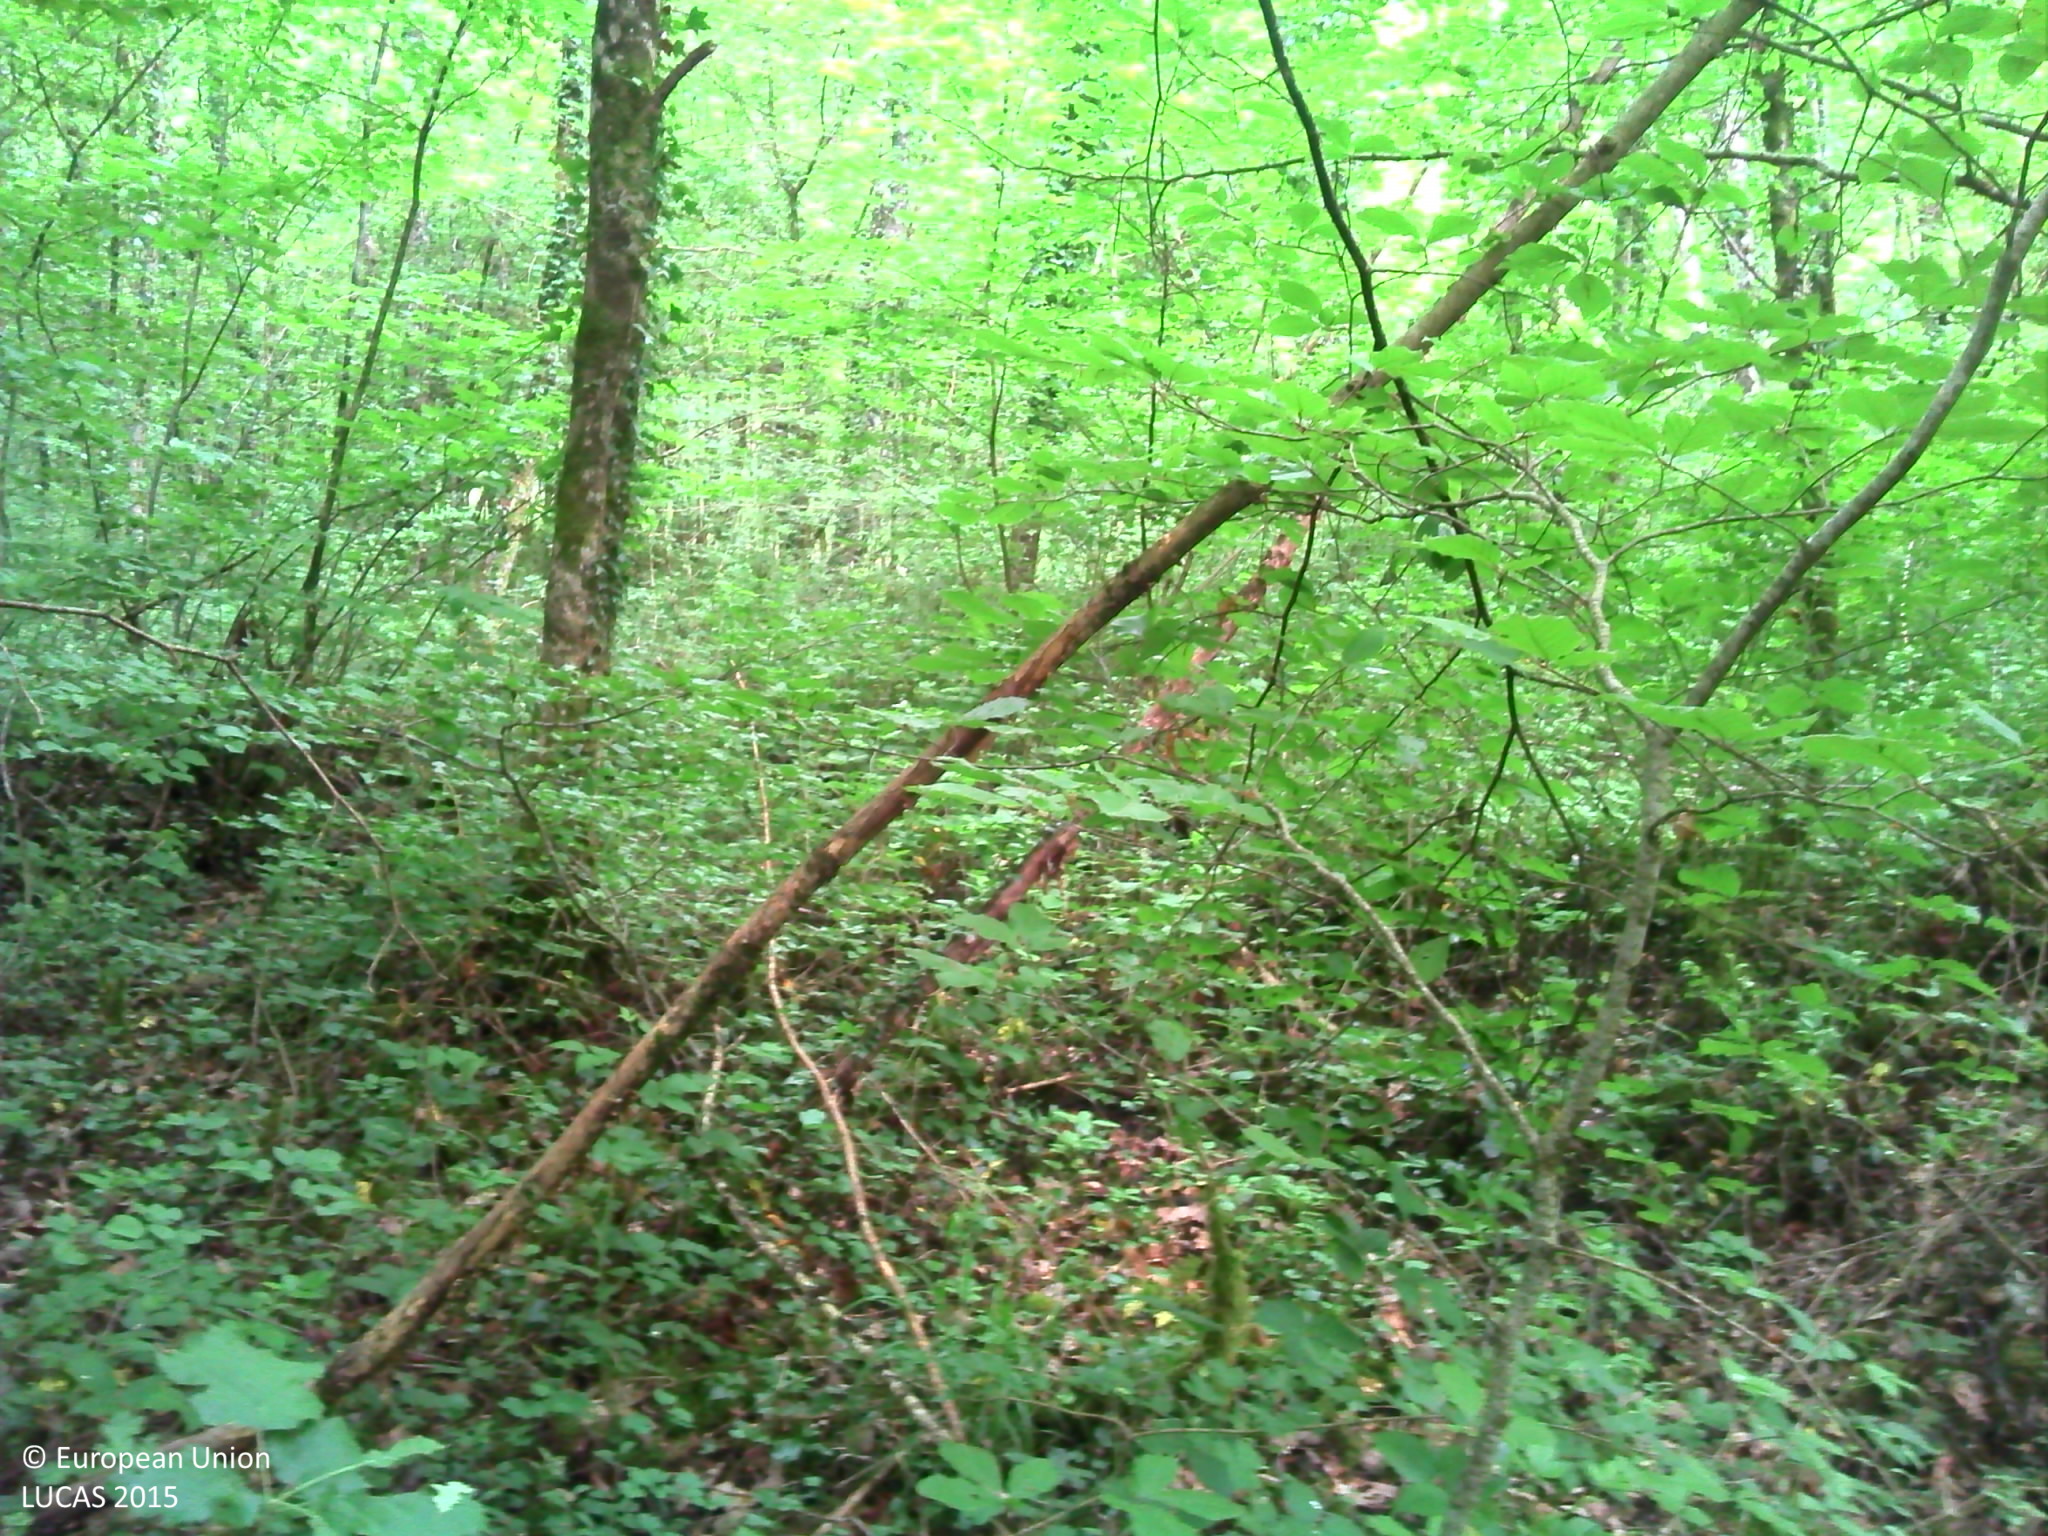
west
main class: Woodland
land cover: Broadleaved woodland
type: beech forest
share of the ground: > 75 %
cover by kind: broadleaved forest trees 90 %, herbaceous plants 10 %
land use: Forestry
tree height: > 5 m
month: June
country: FR
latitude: 47.7653
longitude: 6.3053
